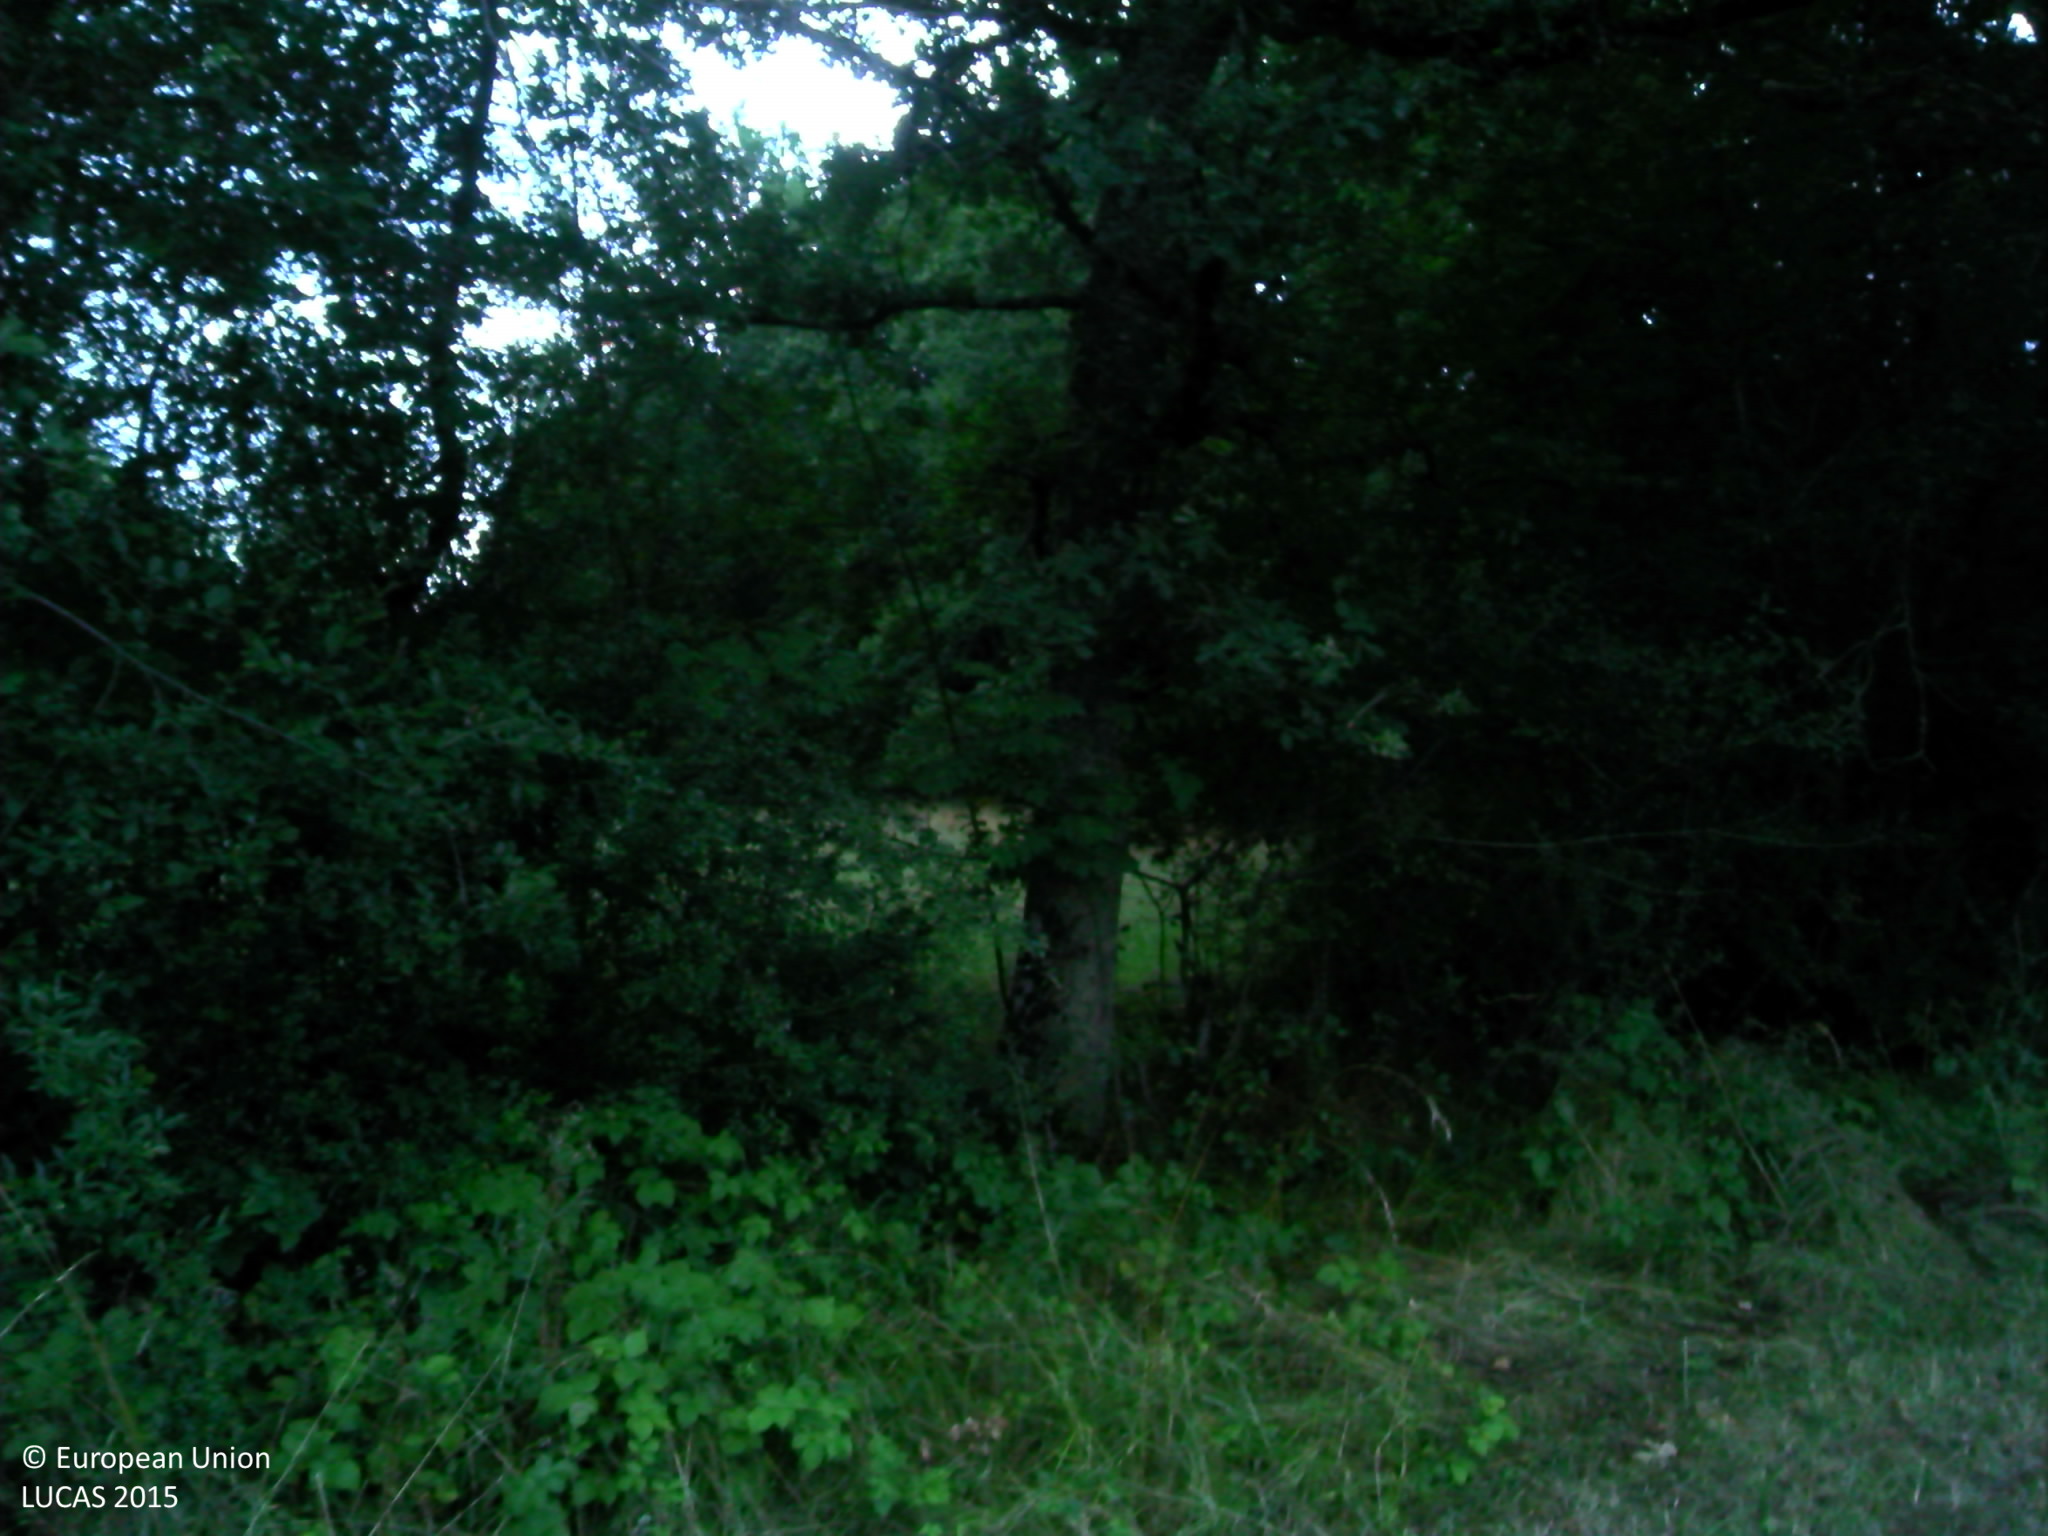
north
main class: Grassland
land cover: Grassland without tree/shrub cover
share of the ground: > 75 %
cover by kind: herbaceous plants 100 %
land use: Agriculture (excluding fallow land and kitchen gardens)
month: August
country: FR
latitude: 46.1612
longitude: 2.2639
